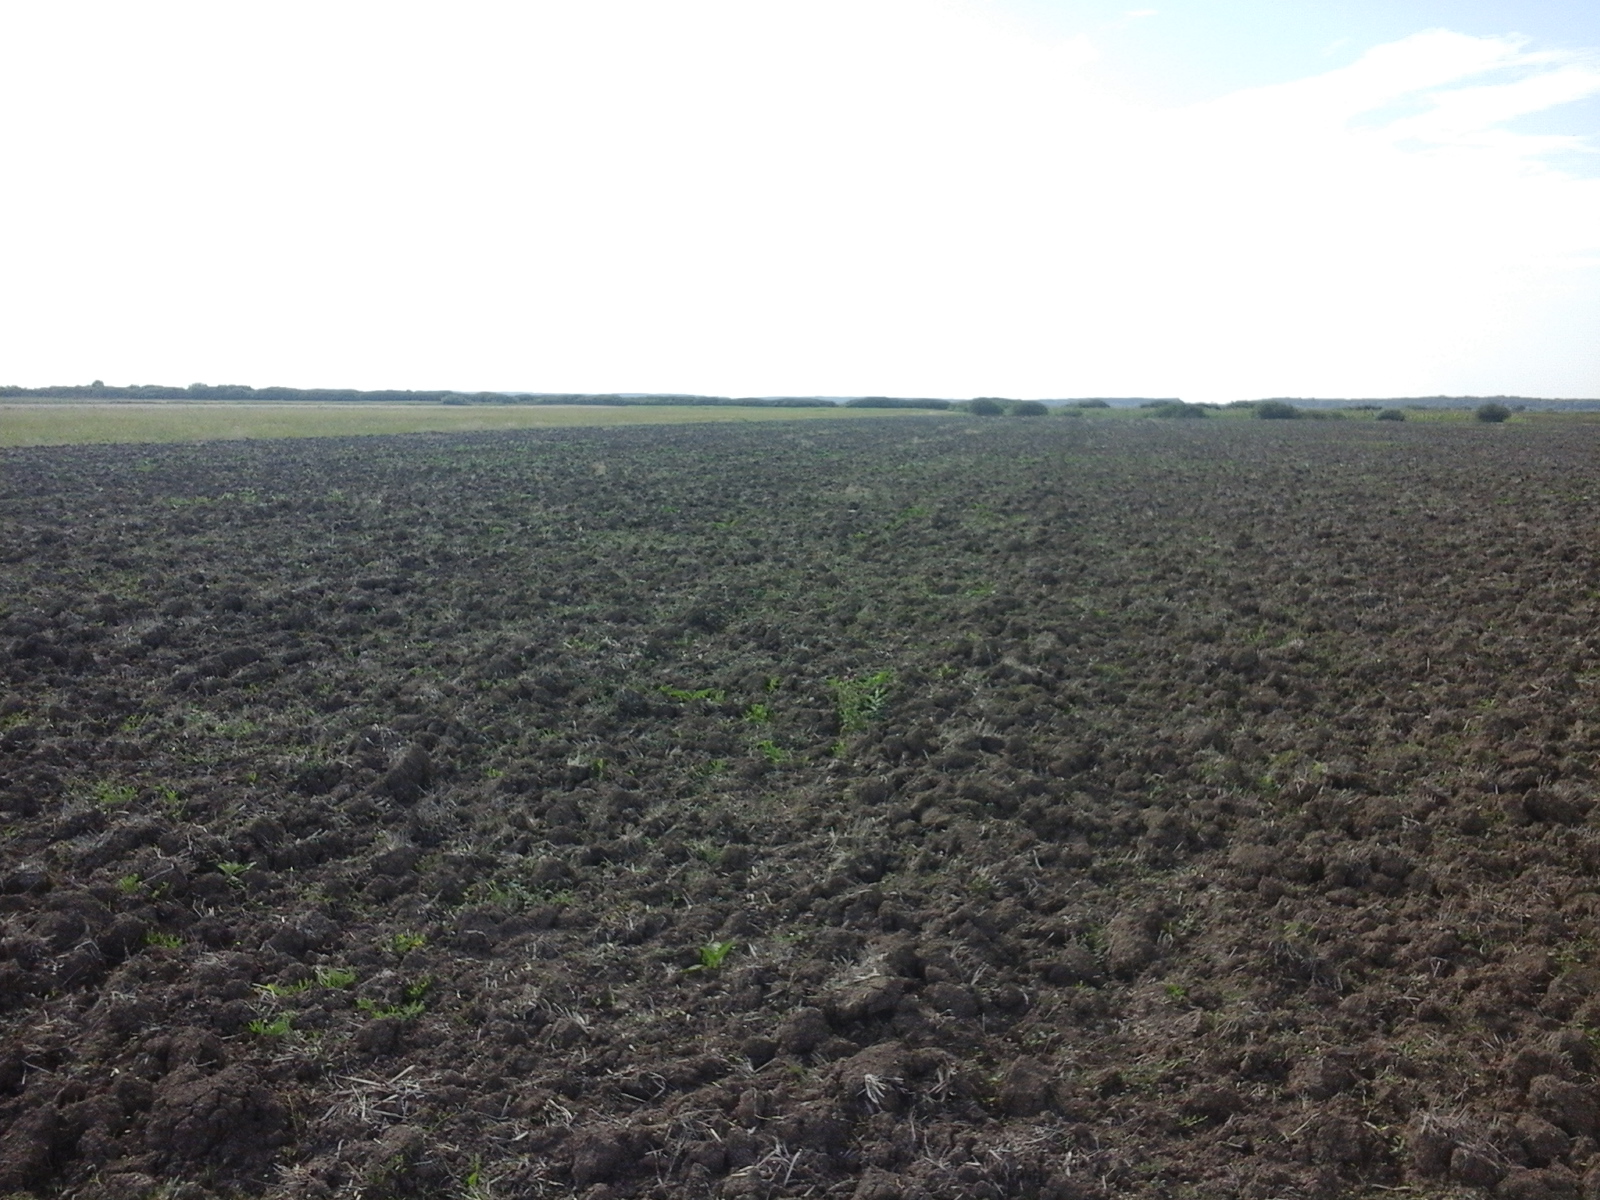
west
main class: Cropland
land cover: Common wheat
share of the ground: < 10 %
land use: Agriculture (excluding fallow land and kitchen gardens)
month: August
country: RO
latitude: 46.6412
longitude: 21.4692
